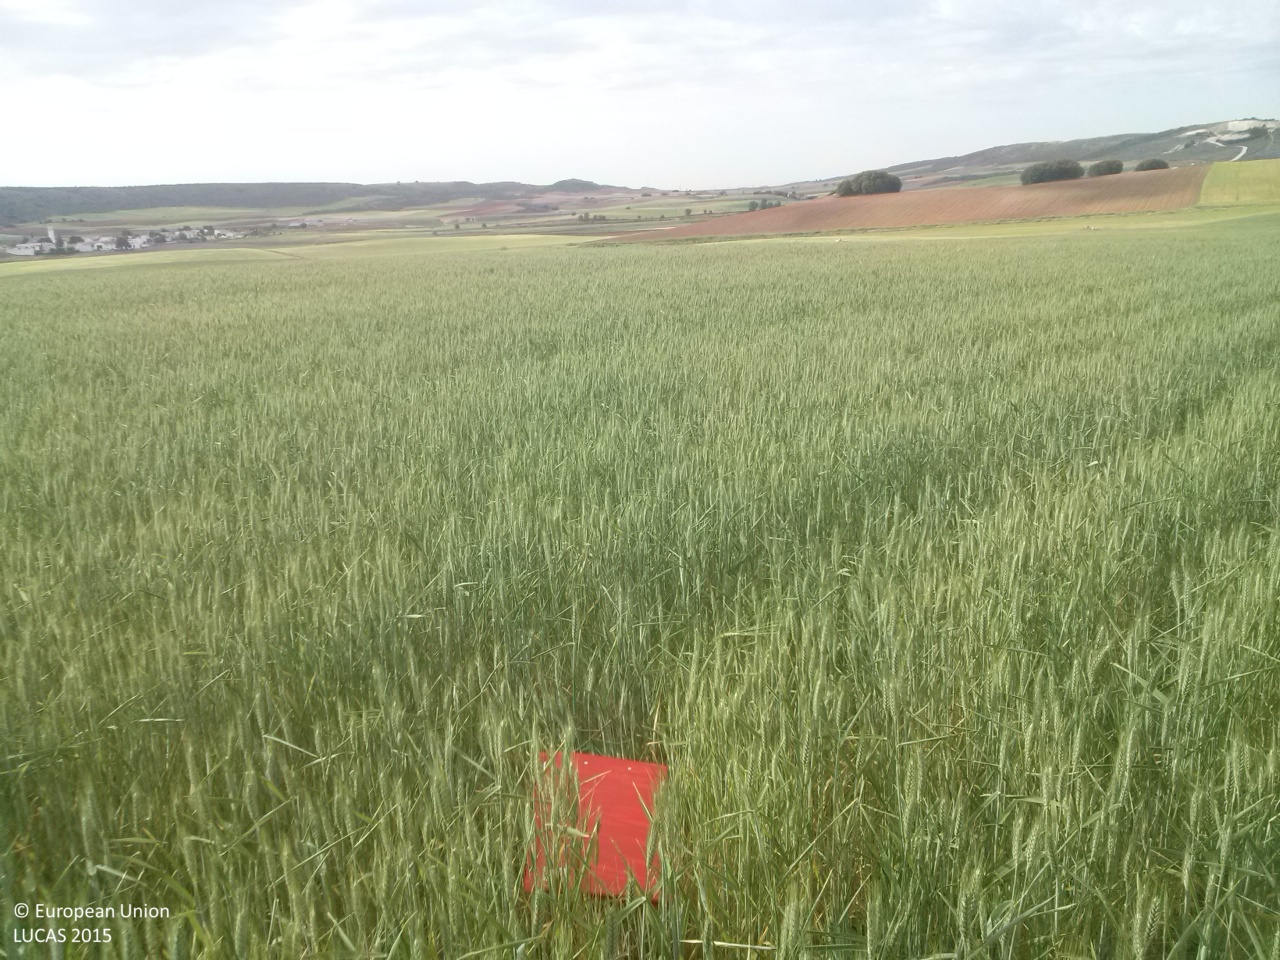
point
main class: Cropland
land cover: Common wheat
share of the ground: > 75 %
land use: Agriculture (excluding fallow land and kitchen gardens)
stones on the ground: < 10 %
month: May
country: ES
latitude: 40.0754
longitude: -2.8632
